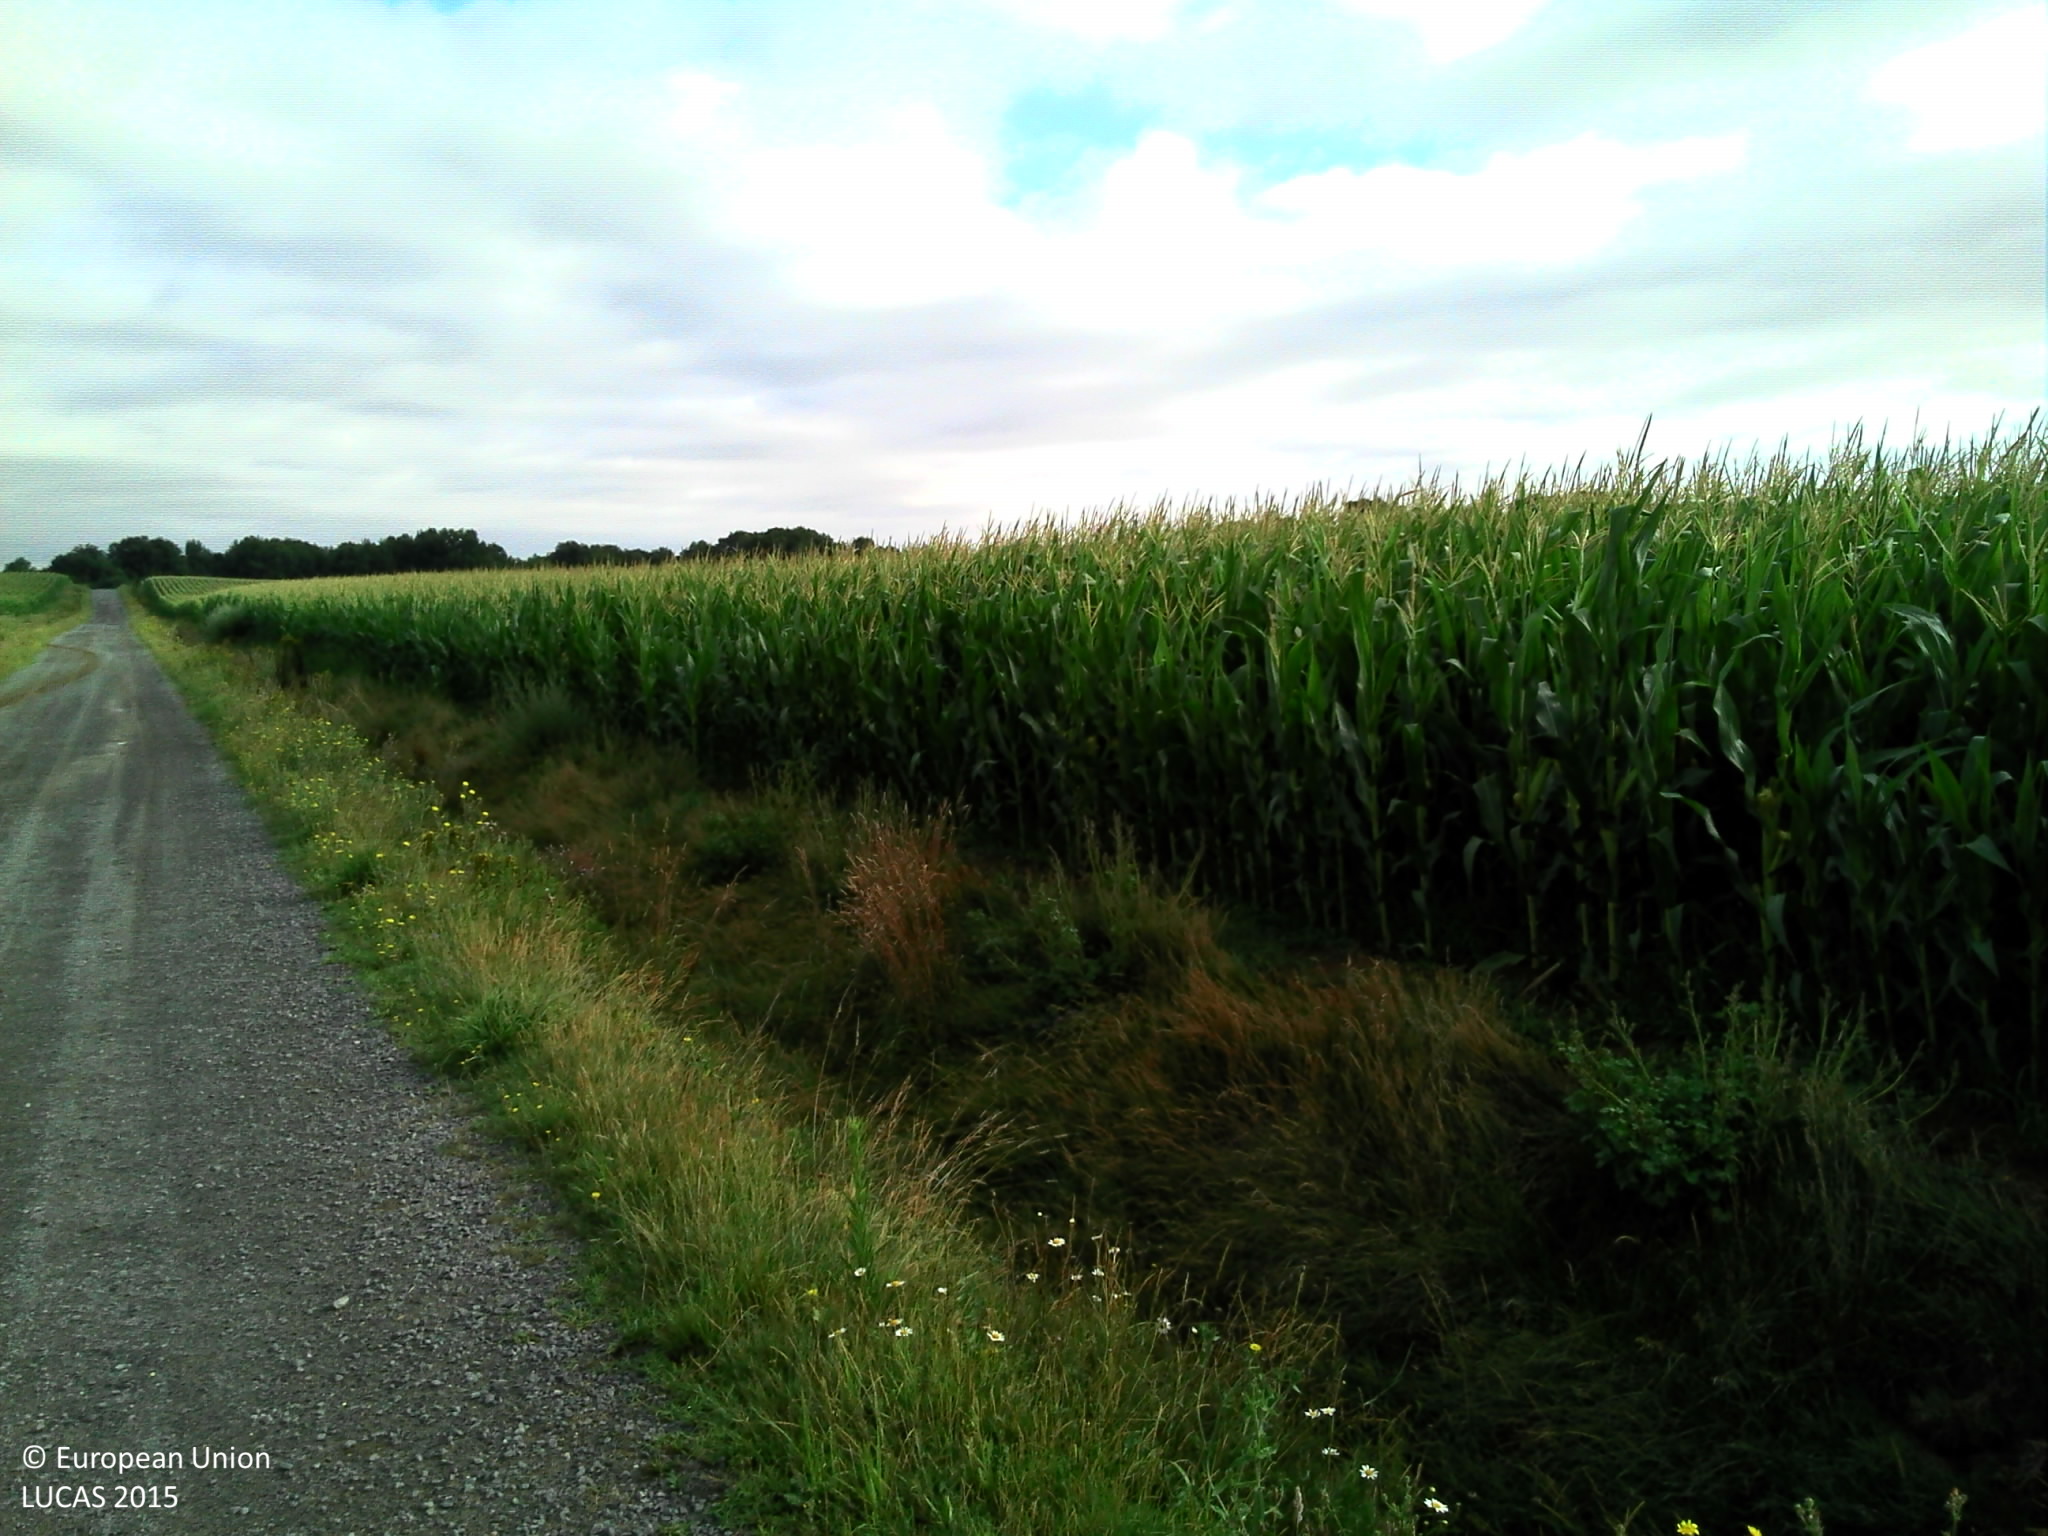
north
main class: Cropland
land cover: Maize
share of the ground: > 75 %
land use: Agriculture (excluding fallow land and kitchen gardens)
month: July
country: FR
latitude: 46.2988
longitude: 0.5979
